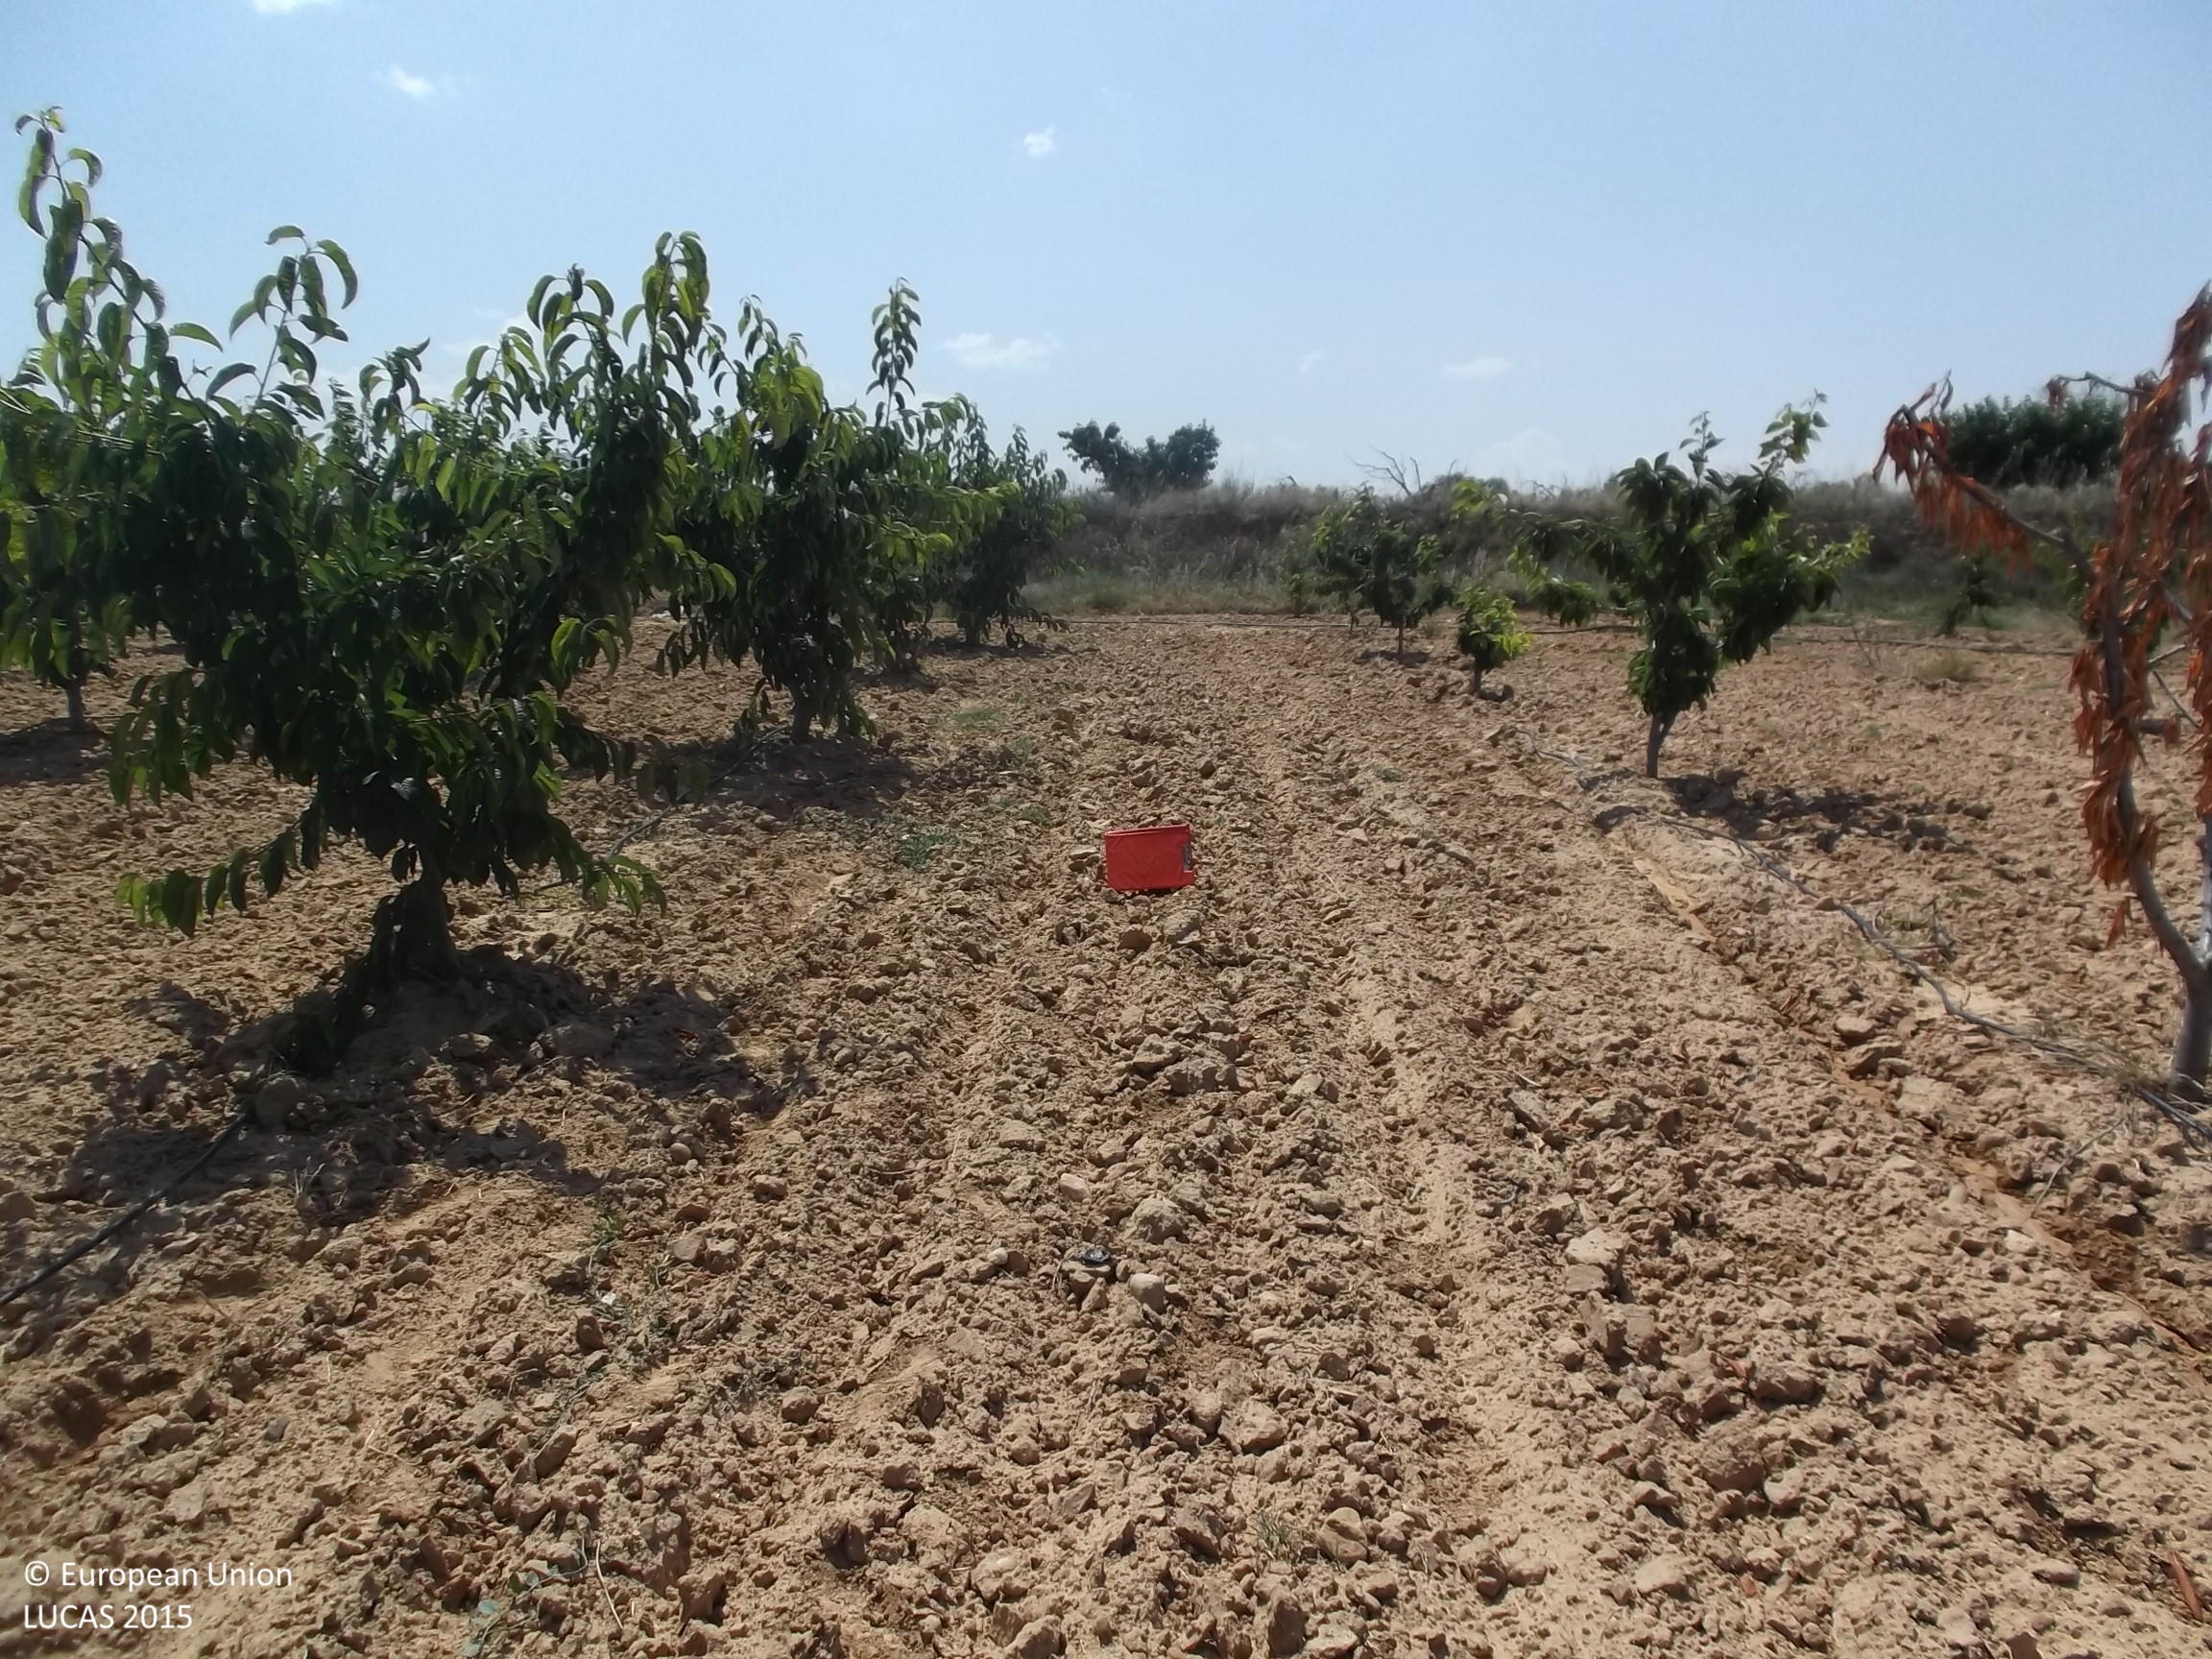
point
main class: Cropland
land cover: Cherry fruit
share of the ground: 10 - 25 %
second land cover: Other bare soil
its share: > 75 %
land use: Agriculture (excluding fallow land and kitchen gardens)
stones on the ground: < 10 %
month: June
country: ES
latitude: 42.2037
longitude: -2.0646
